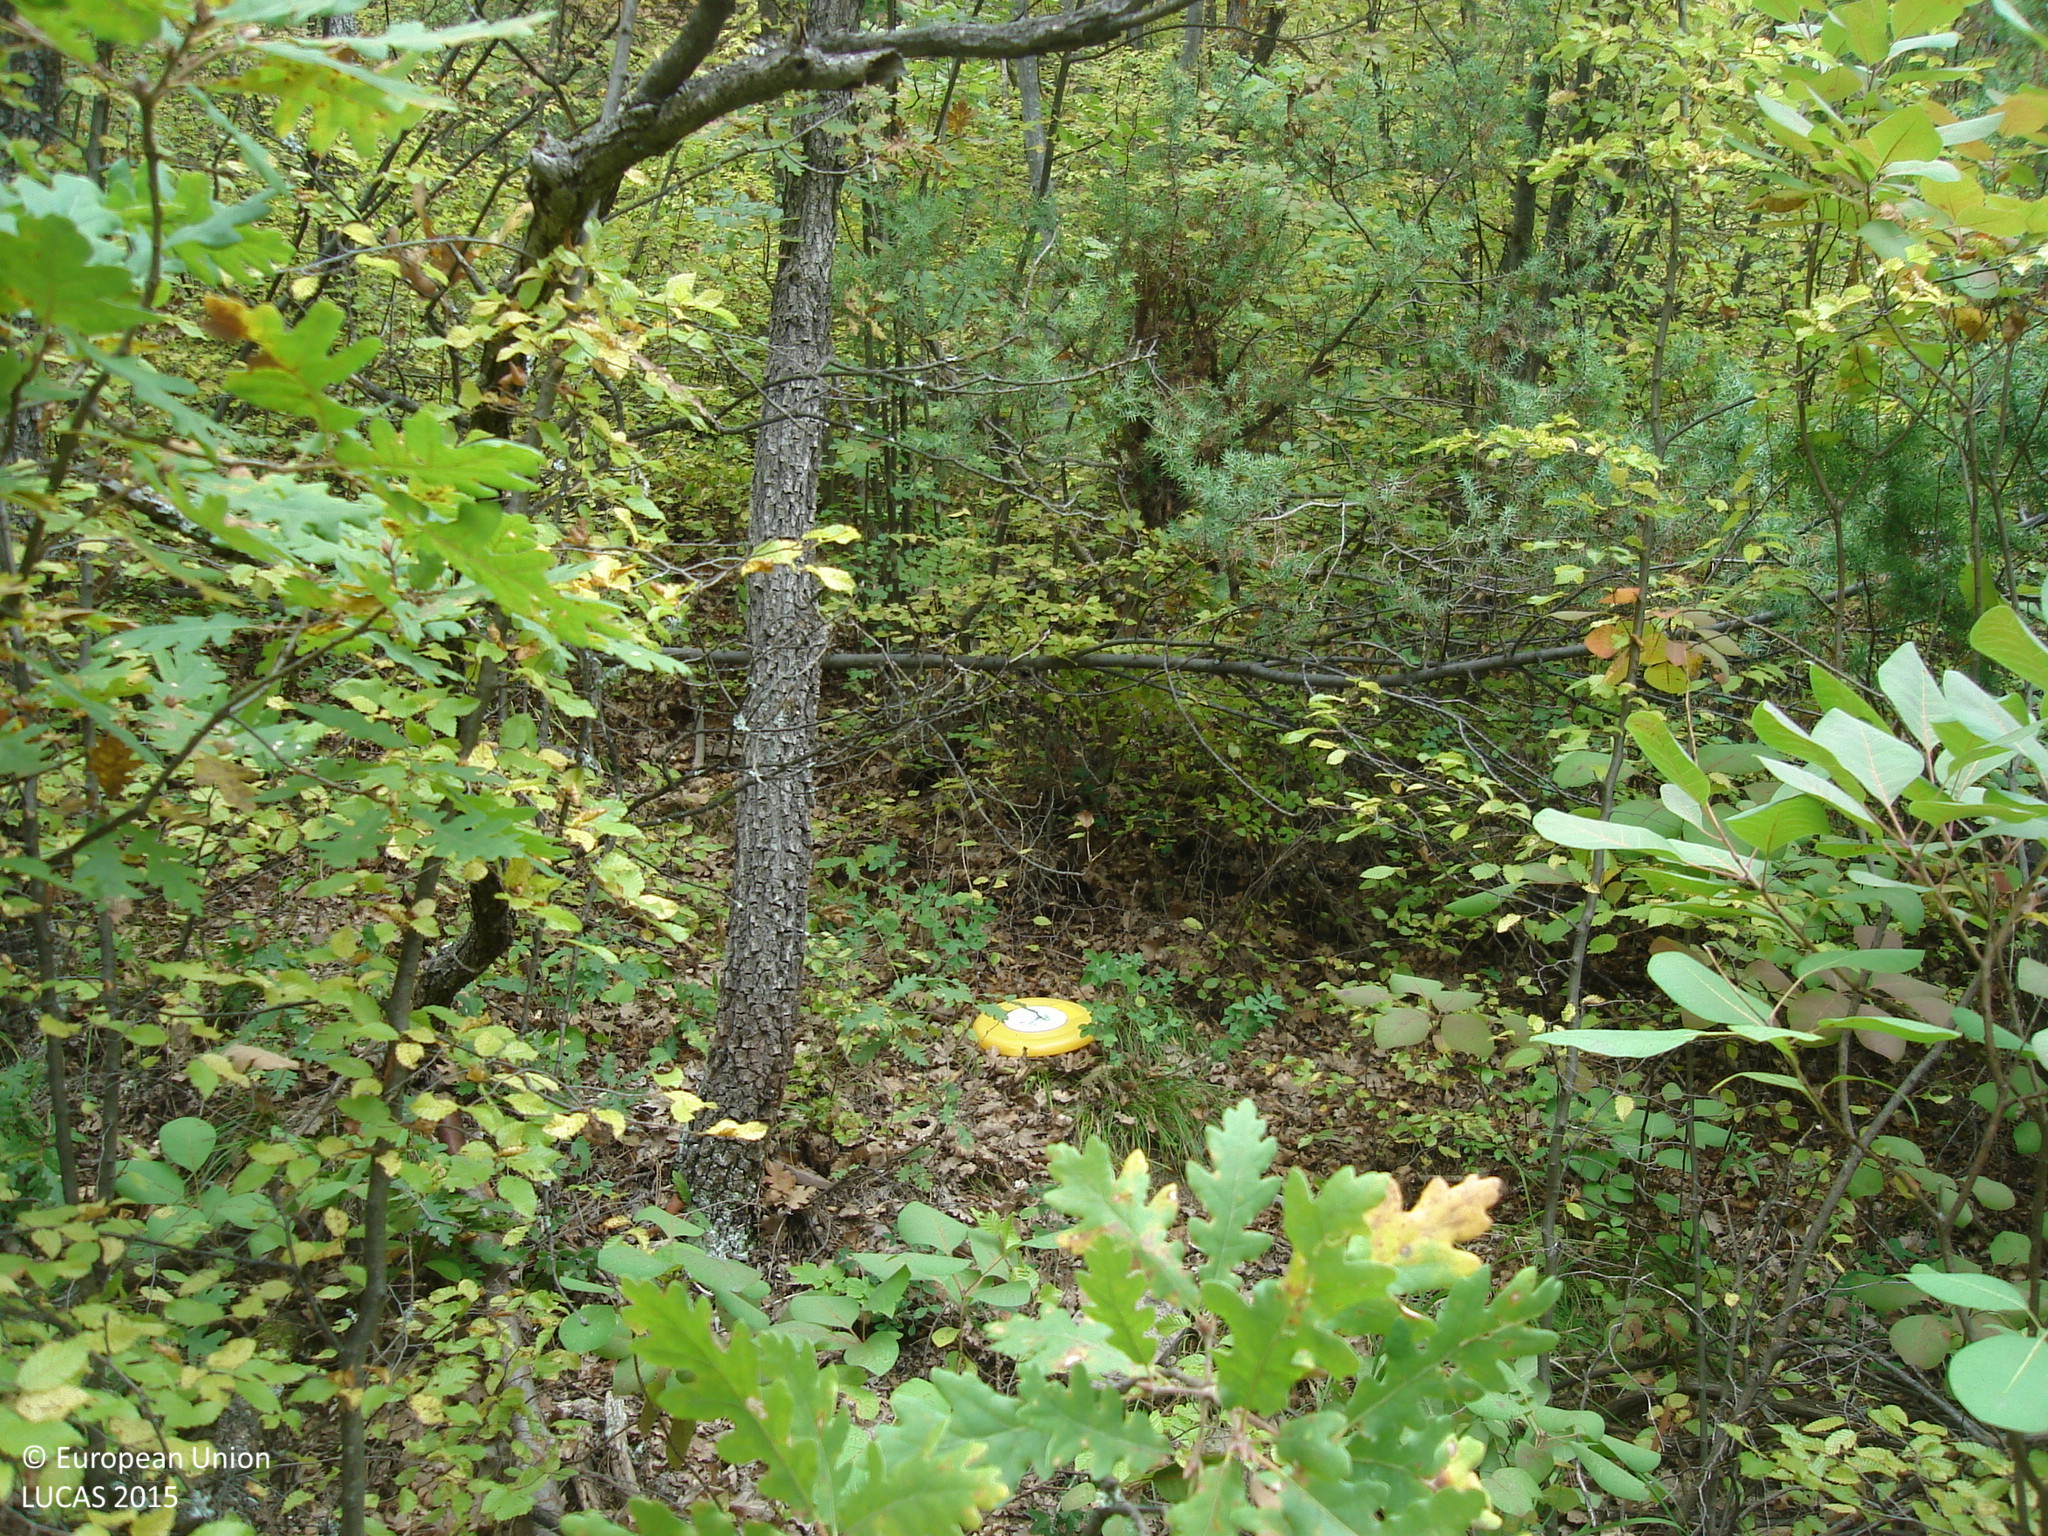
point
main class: Woodland
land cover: Broadleaved woodland
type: mesophytic deciduous forest
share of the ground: > 75 %
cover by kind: broadleaved forest trees 80 %, shrubs 10 %, herbaceous plants 5 %, unconsolidated bare surface 5 %
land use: Forestry
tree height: > 5 m
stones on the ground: < 10 %
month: October
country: BG
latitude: 42.6127
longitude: 23.9771
